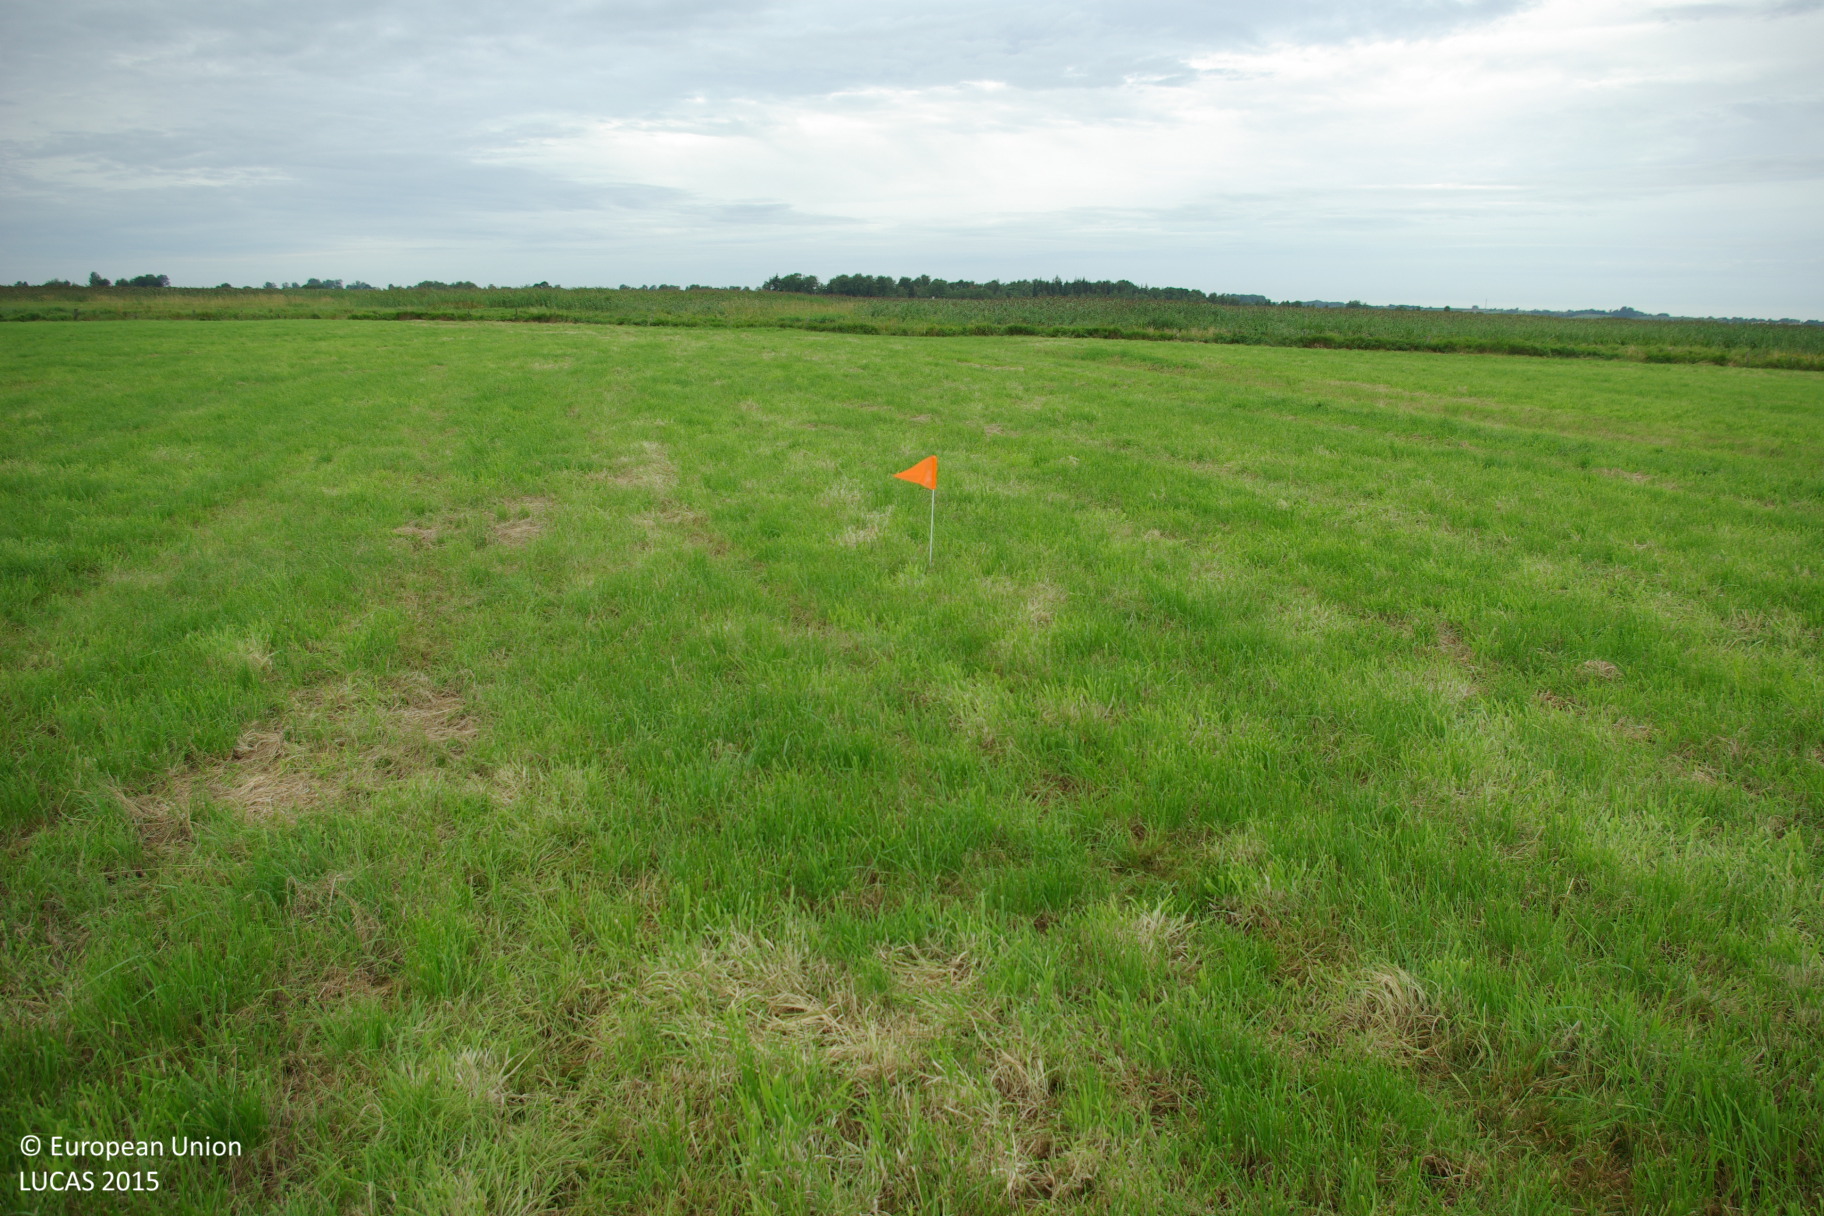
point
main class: Grassland
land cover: Grassland without tree/shrub cover
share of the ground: > 75 %
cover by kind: herbaceous plants 100 %
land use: Agriculture (excluding fallow land and kitchen gardens)
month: August
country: DE
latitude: 54.3345
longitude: 9.3084
